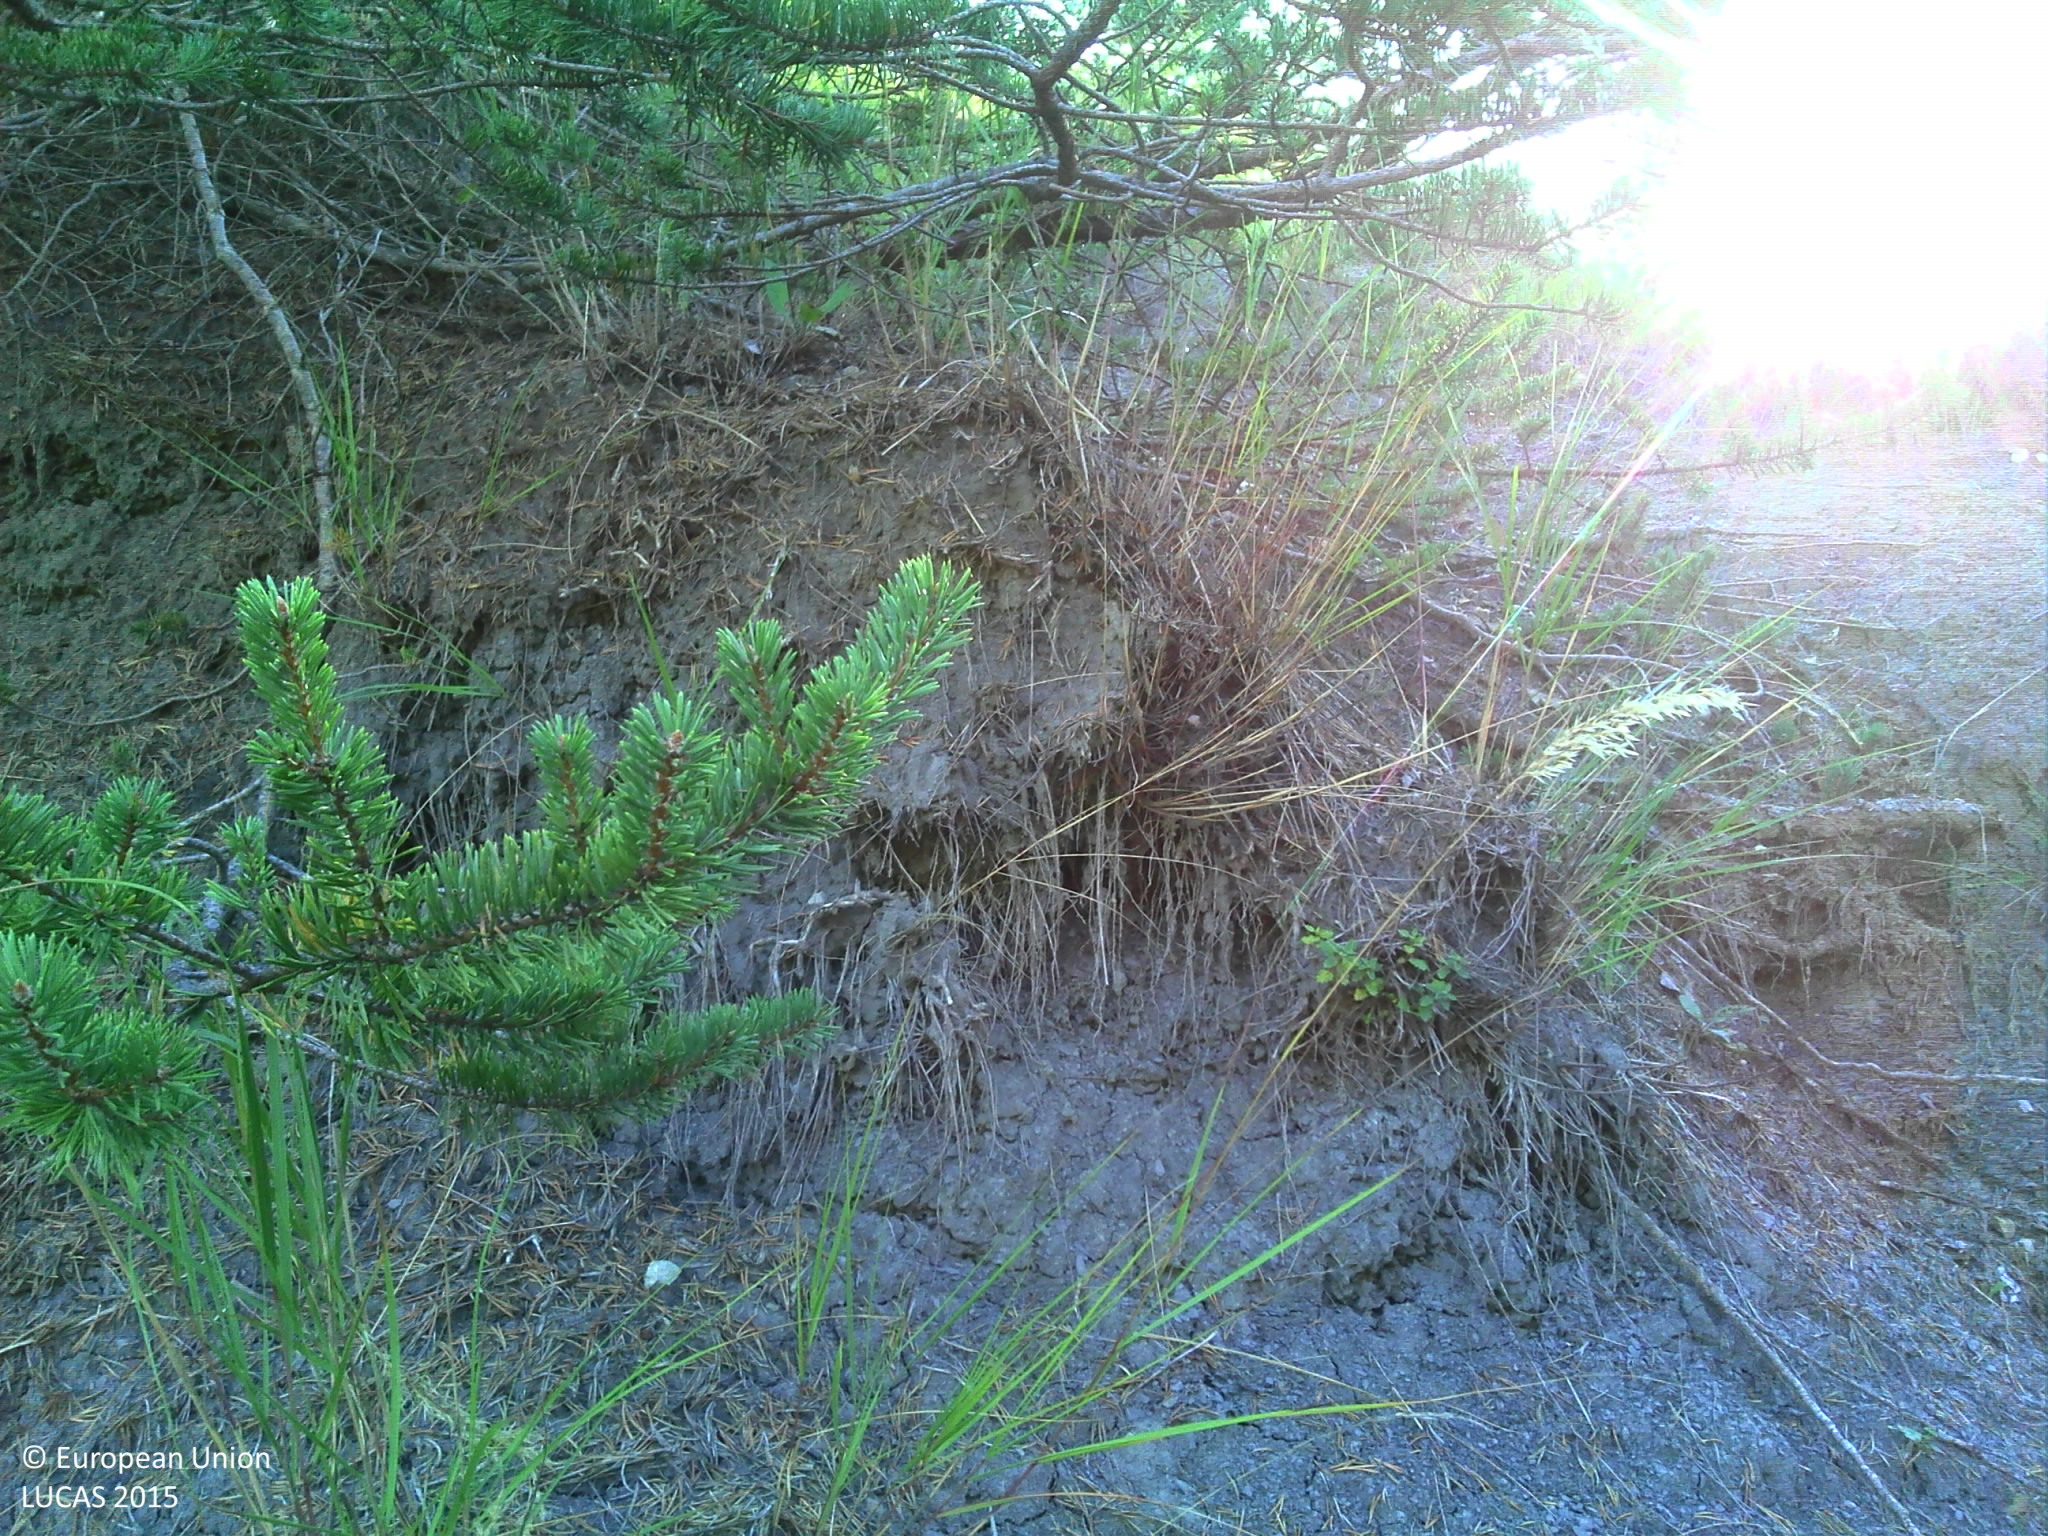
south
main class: Shrubland
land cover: Shrubland with sparse tree cover
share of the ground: > 75 %
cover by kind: shrubs 65 %, unconsolidated bare surface 20 %, consolidated bare surface 10 %, coniferous forest trees 5 %
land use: Semi-natural and natural areas not in use
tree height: < 5 m
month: September
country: FR
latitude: 44.4977
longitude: 5.3160
